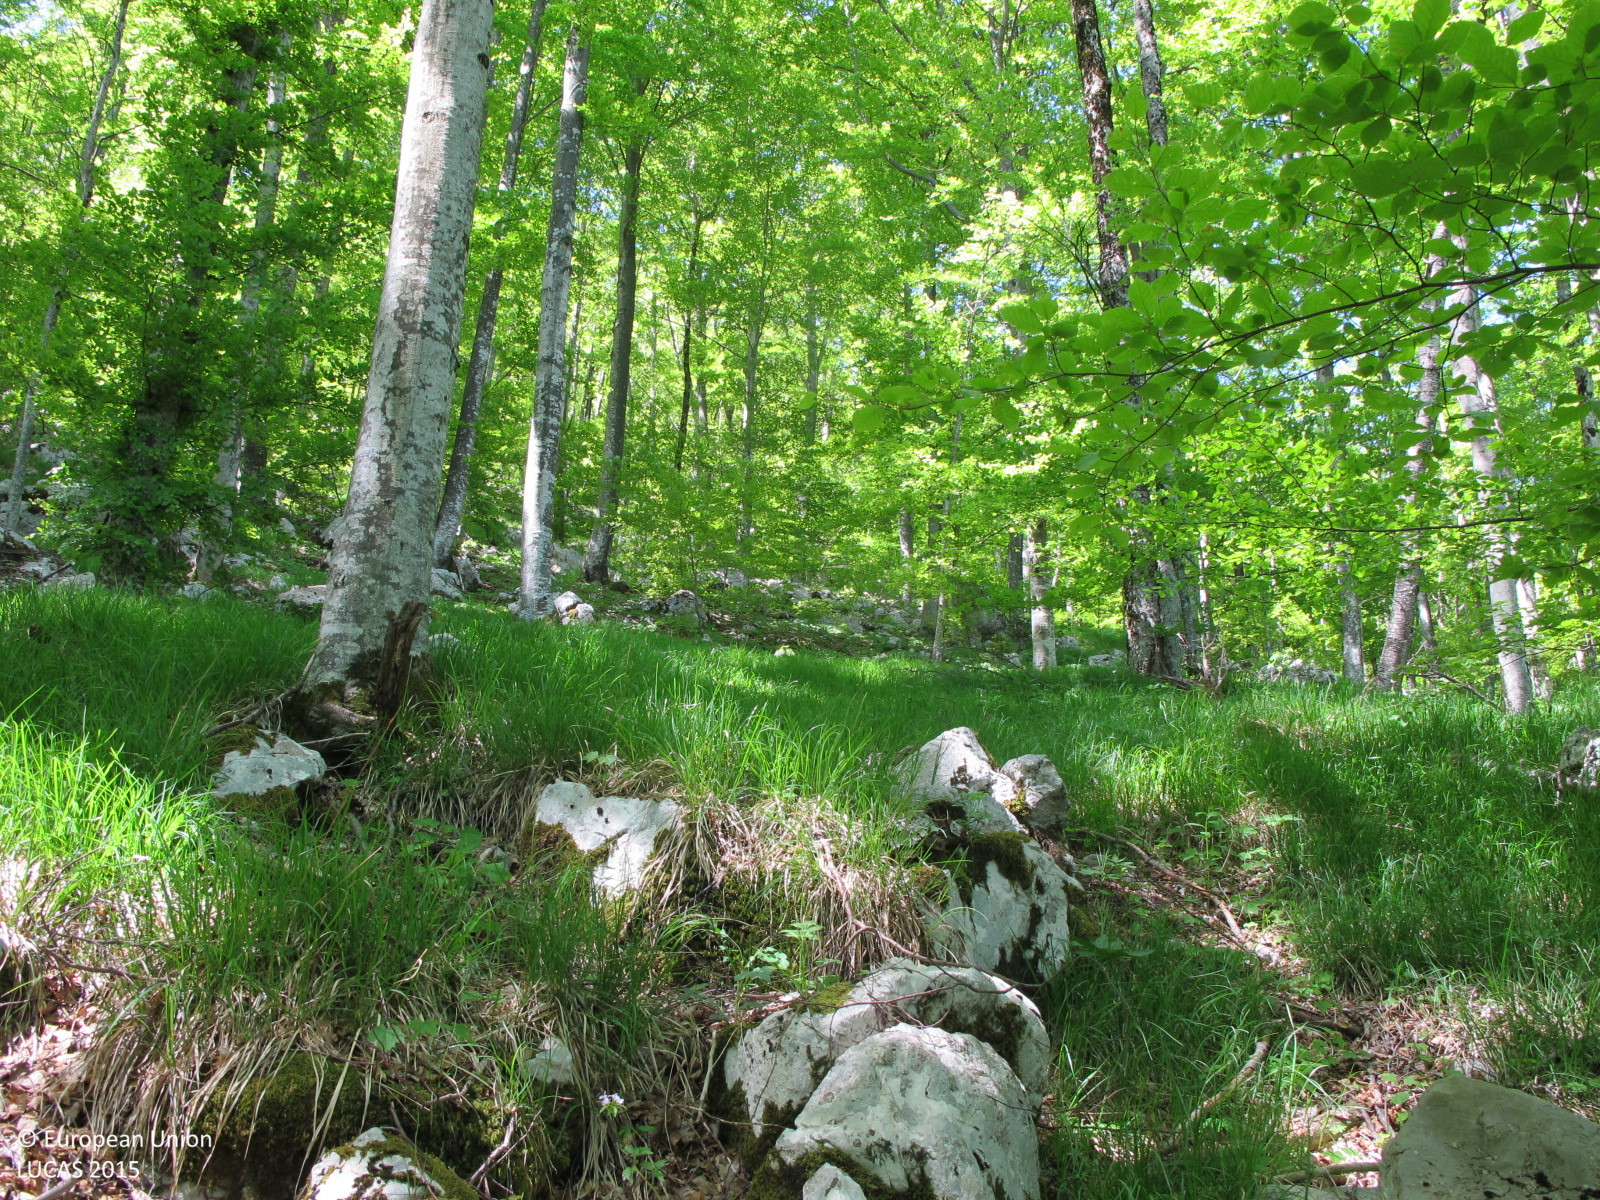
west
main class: Woodland
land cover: Broadleaved woodland
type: mountainous beech forest
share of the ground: > 75 %
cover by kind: broadleaved forest trees 90 %, shrubs 5 %, herbaceous plants 5 %
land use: Forestry
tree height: > 5 m
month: May
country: HR
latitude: 45.3829
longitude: 14.2479
